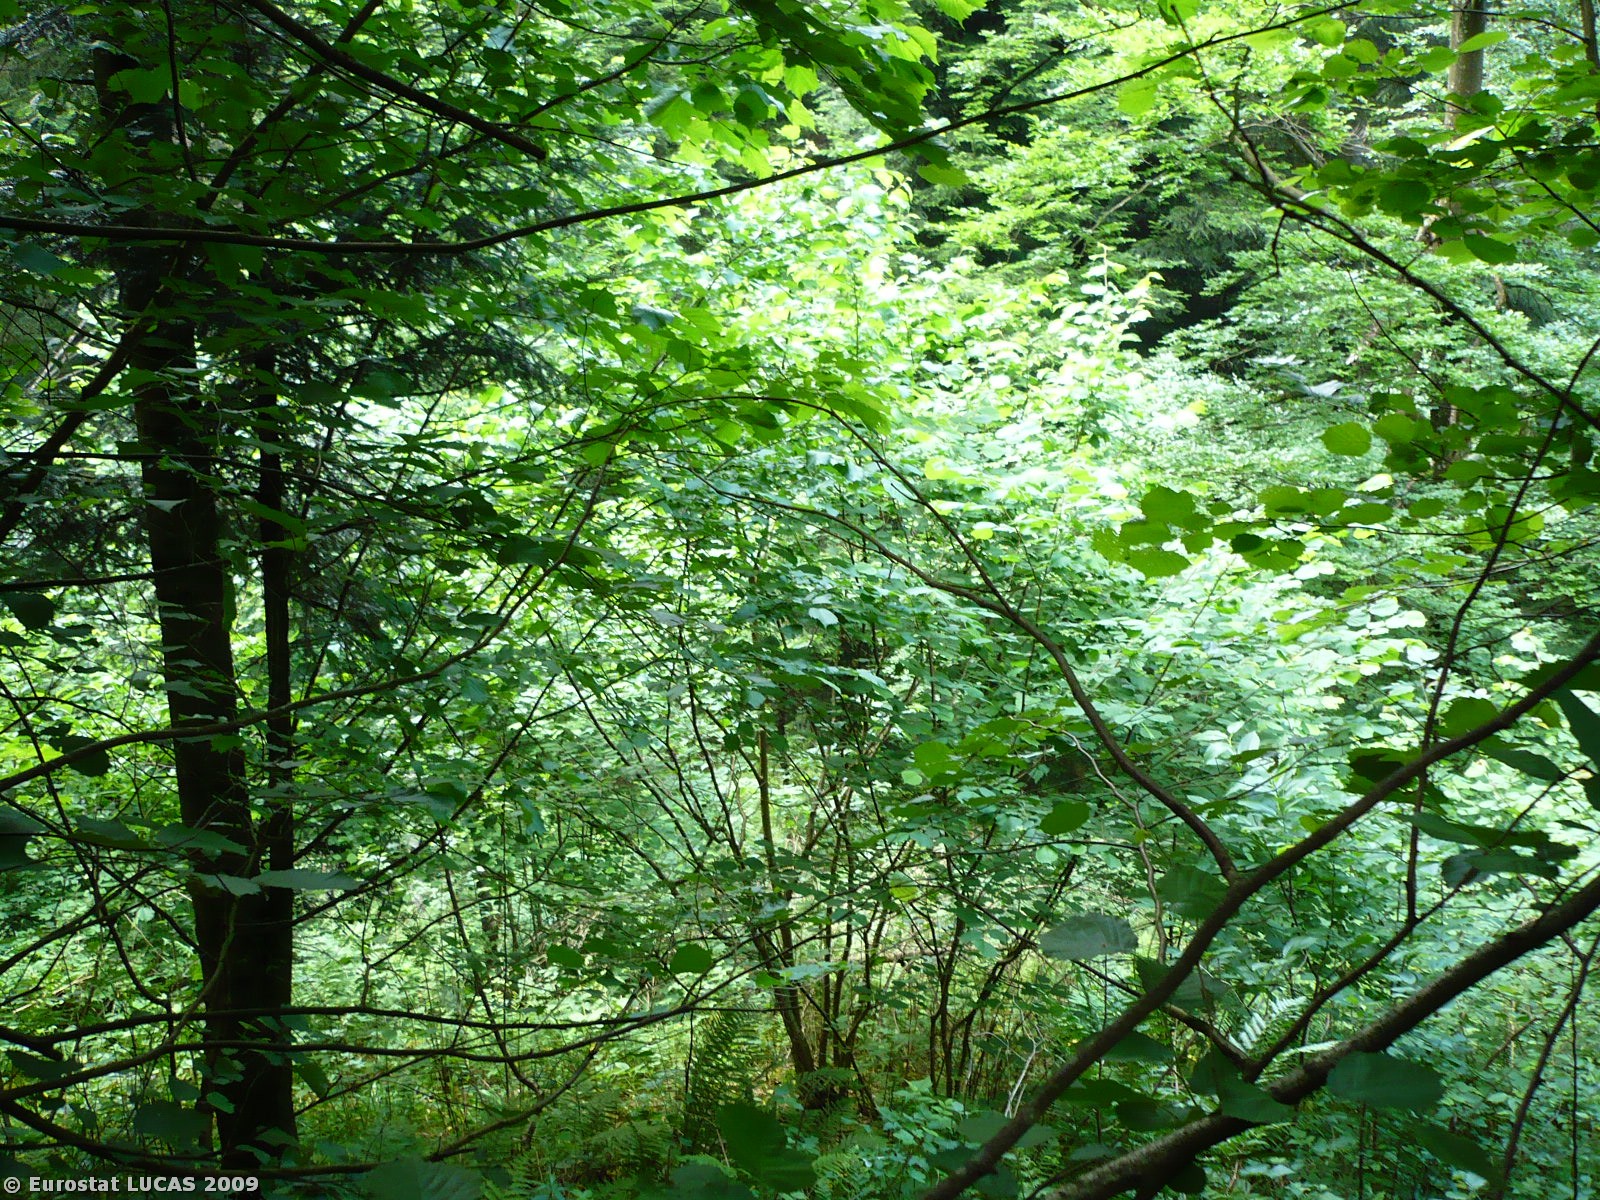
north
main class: Woodland
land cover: Mixed woodland
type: beech forest
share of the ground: > 75 %
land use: Forestry
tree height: > 5 m
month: June
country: SI
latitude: 45.7996
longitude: 14.2031
